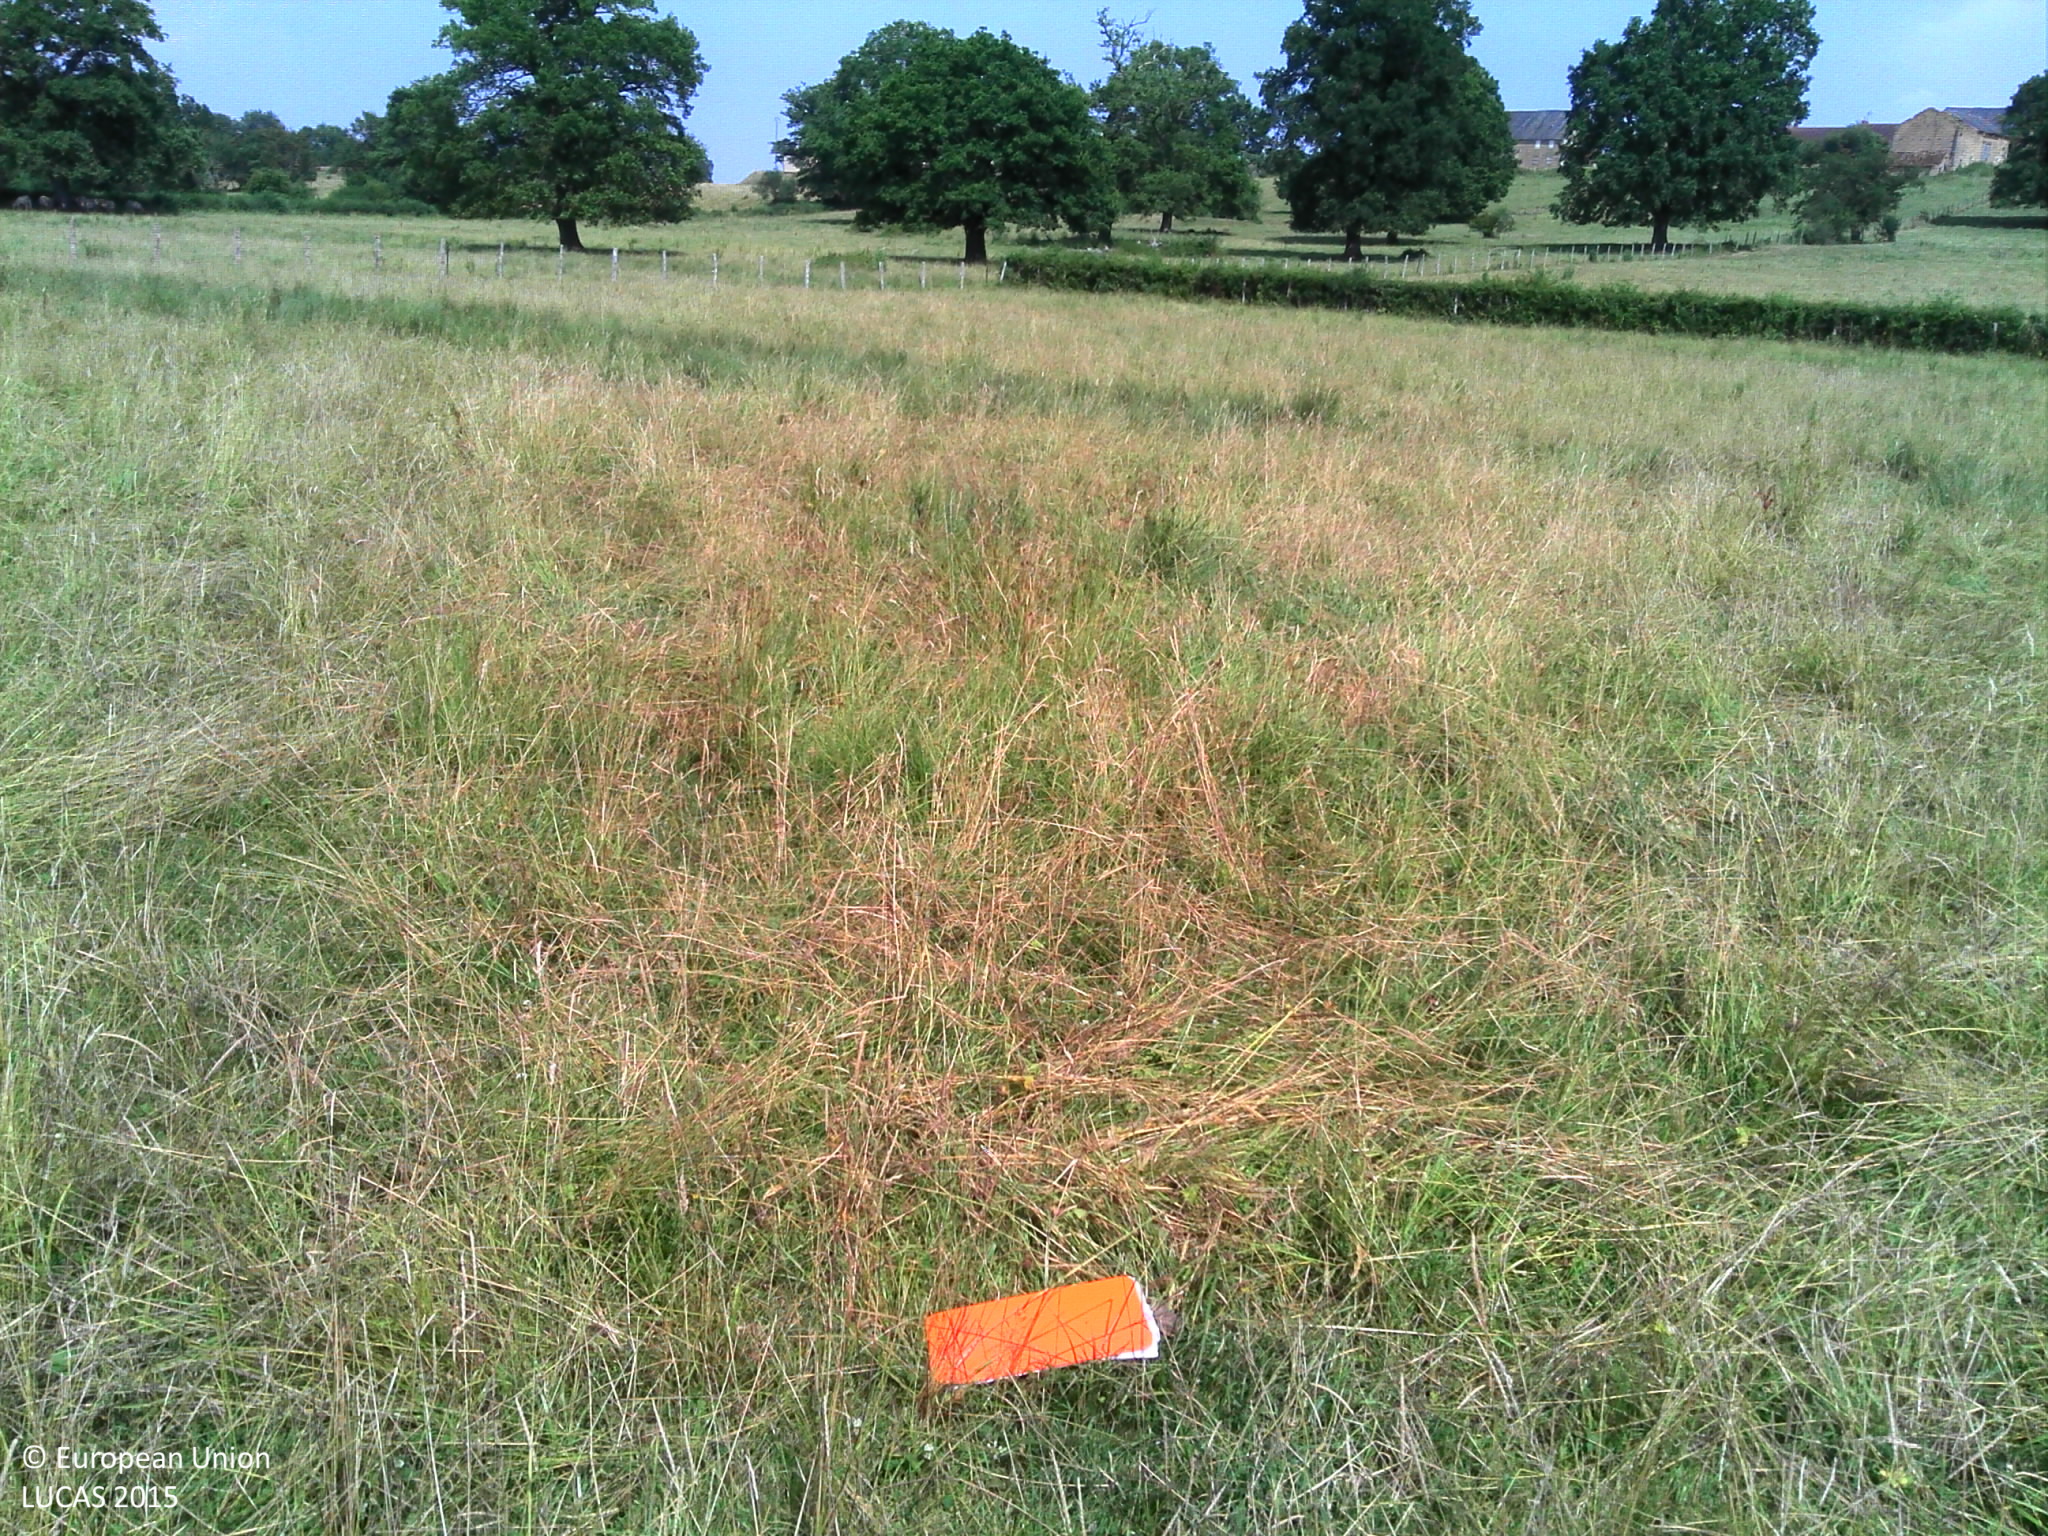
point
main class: Grassland
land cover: Grassland without tree/shrub cover
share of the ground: > 75 %
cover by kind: herbaceous plants 100 %
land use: Agriculture (excluding fallow land and kitchen gardens)
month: July
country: FR
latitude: 47.2215
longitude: 3.5394
